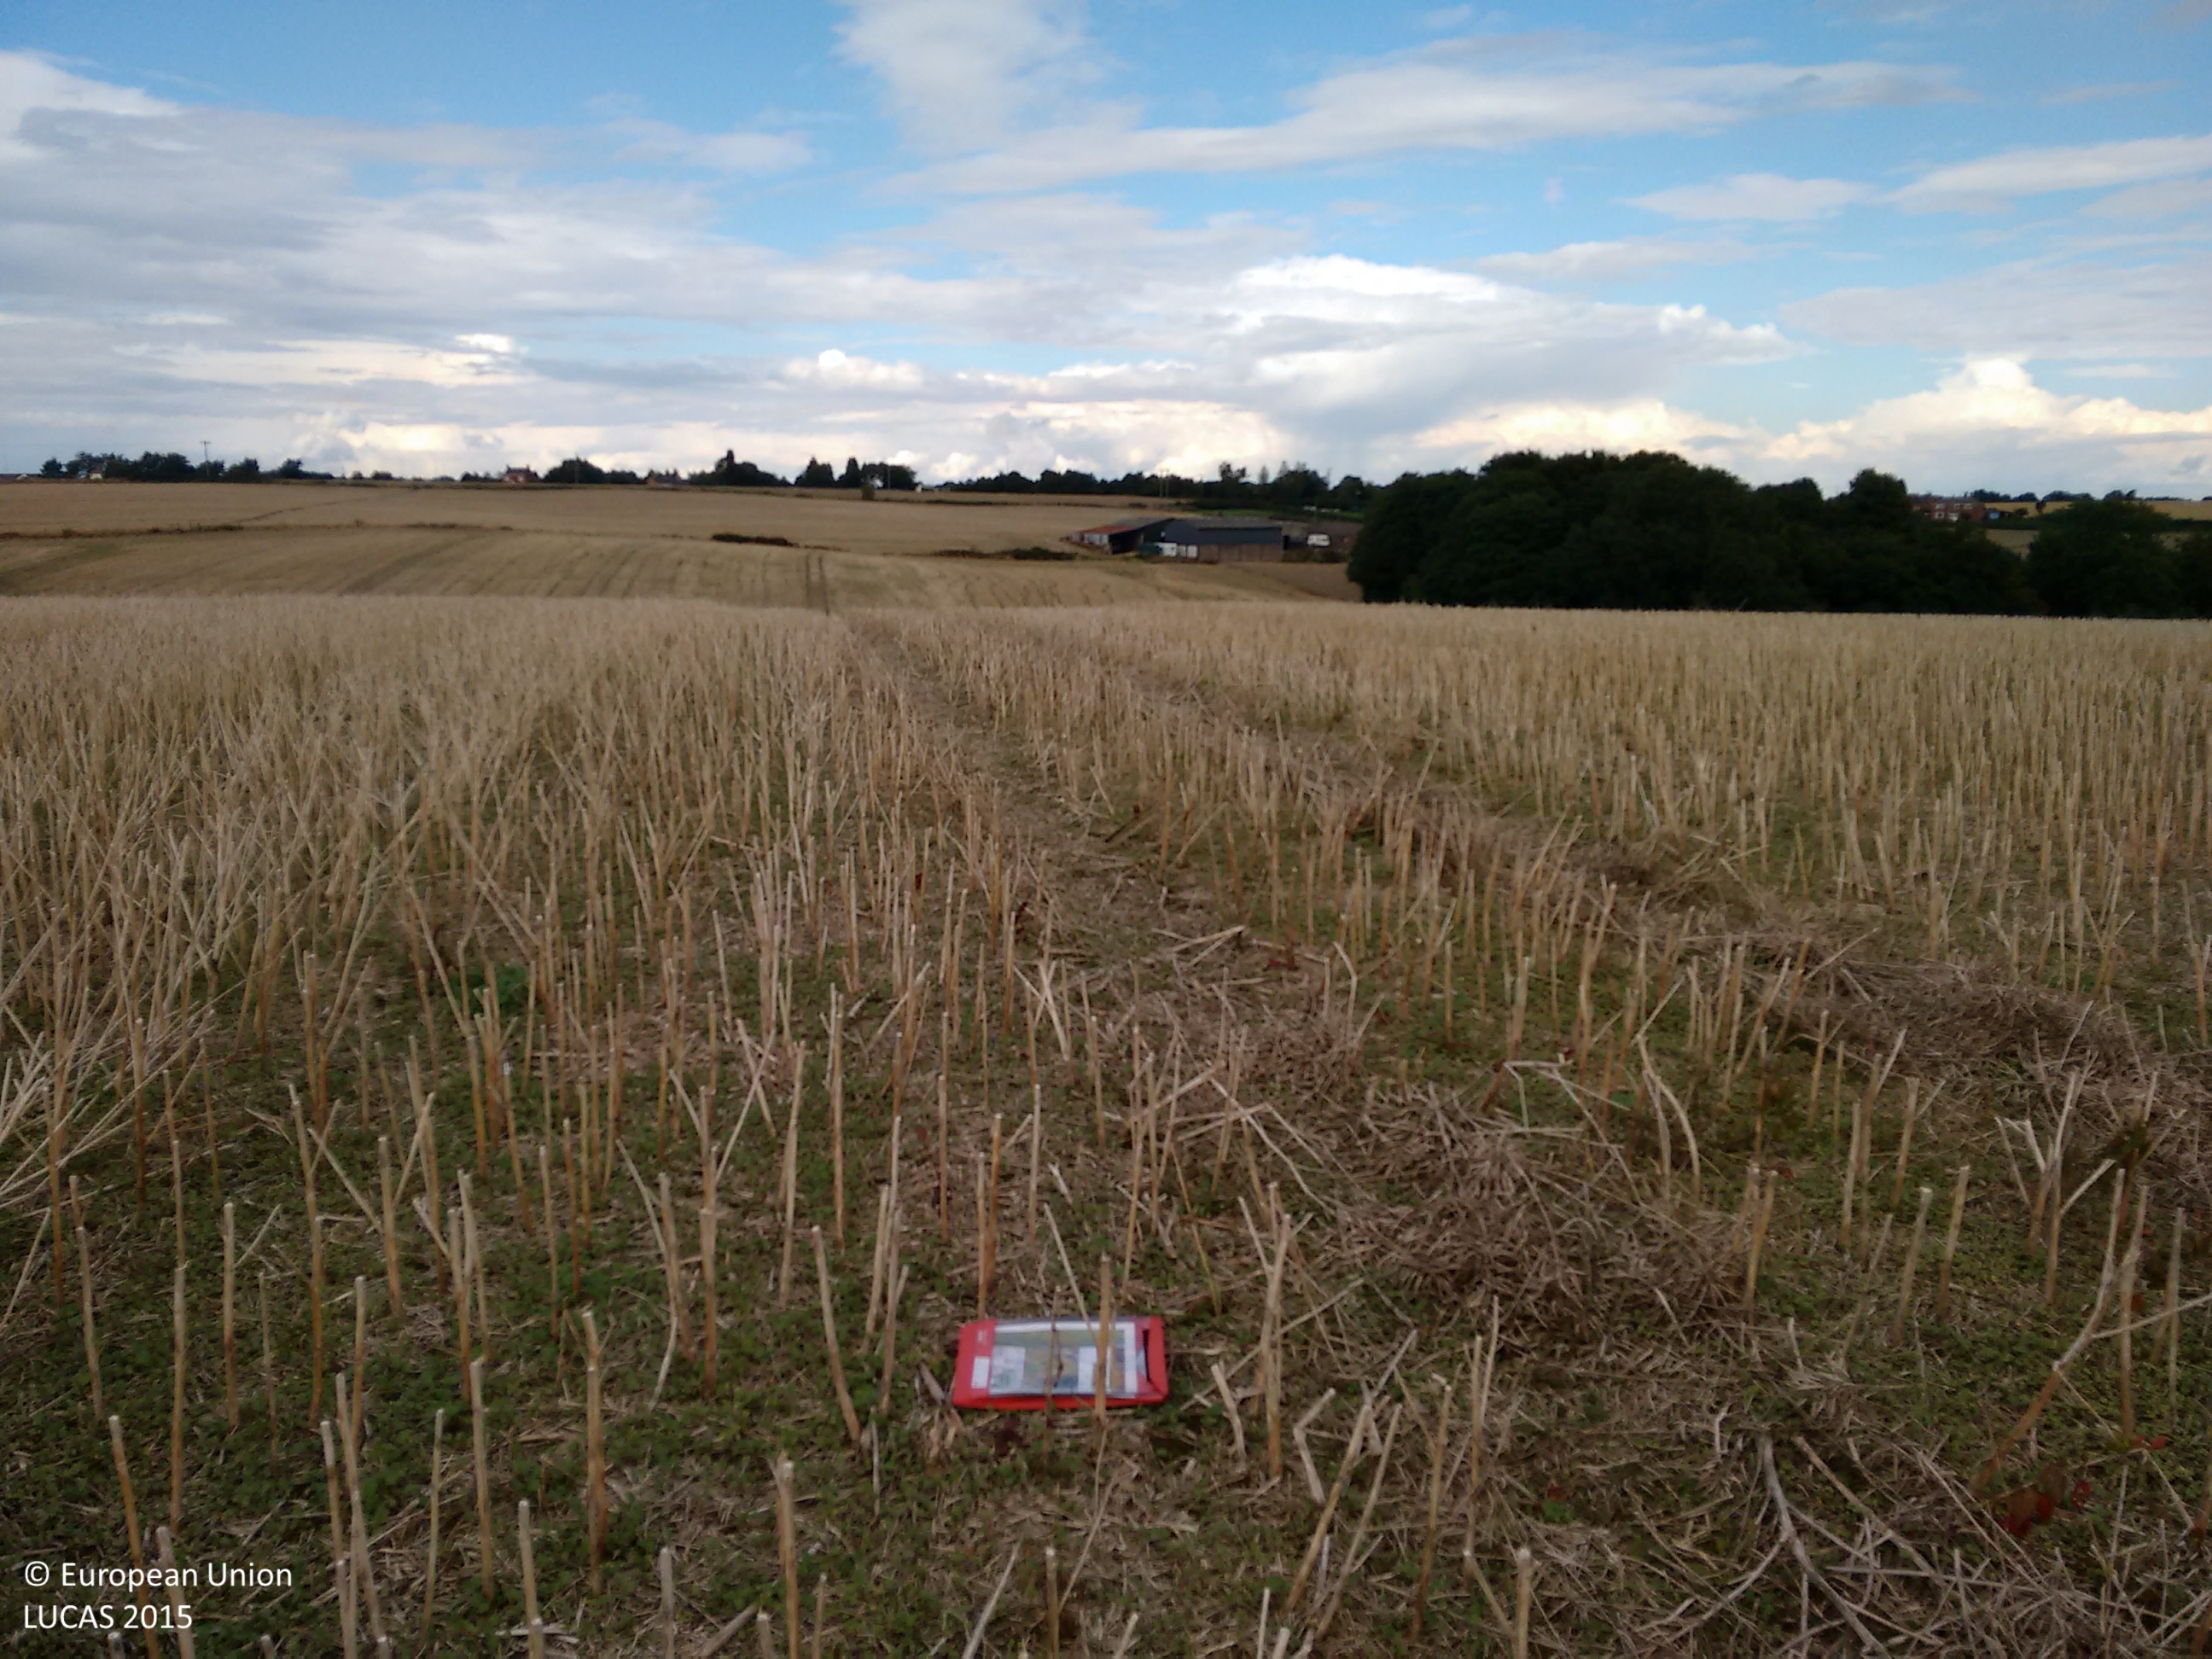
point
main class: Cropland
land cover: Rape and turnip rape
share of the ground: > 75 %
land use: Agriculture (excluding fallow land and kitchen gardens)
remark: Harvested field
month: September
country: GB
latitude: 52.7606
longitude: -1.5057
